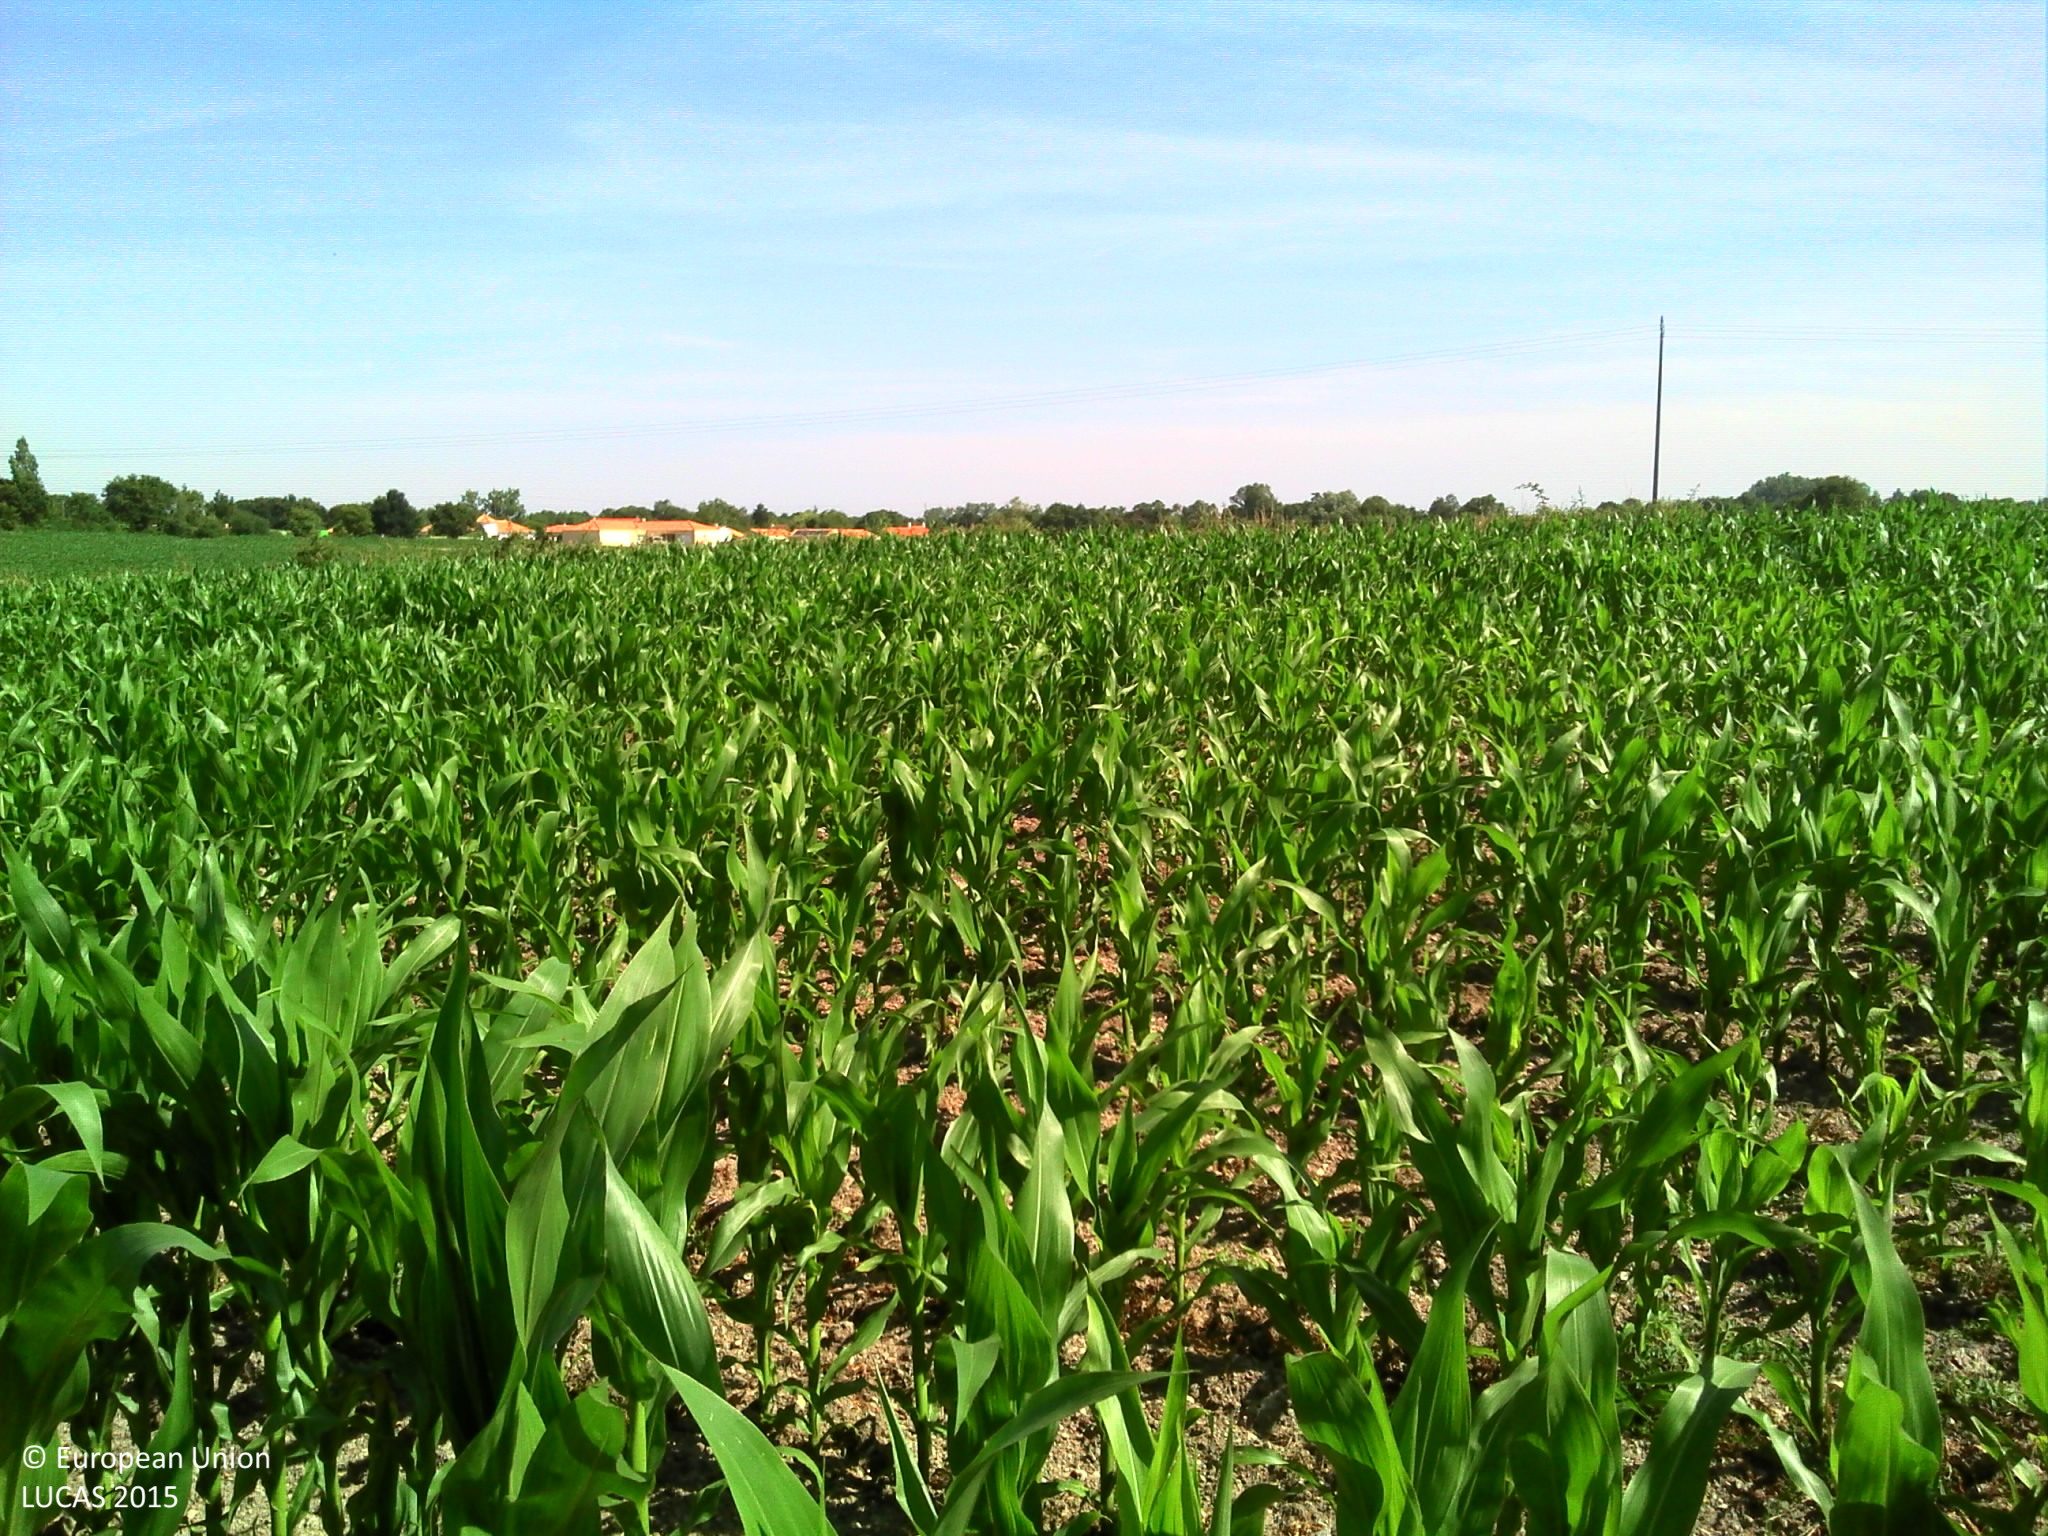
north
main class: Cropland
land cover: Maize
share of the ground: > 75 %
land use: Agriculture (excluding fallow land and kitchen gardens)
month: June
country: FR
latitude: 46.9412
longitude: -1.7215
